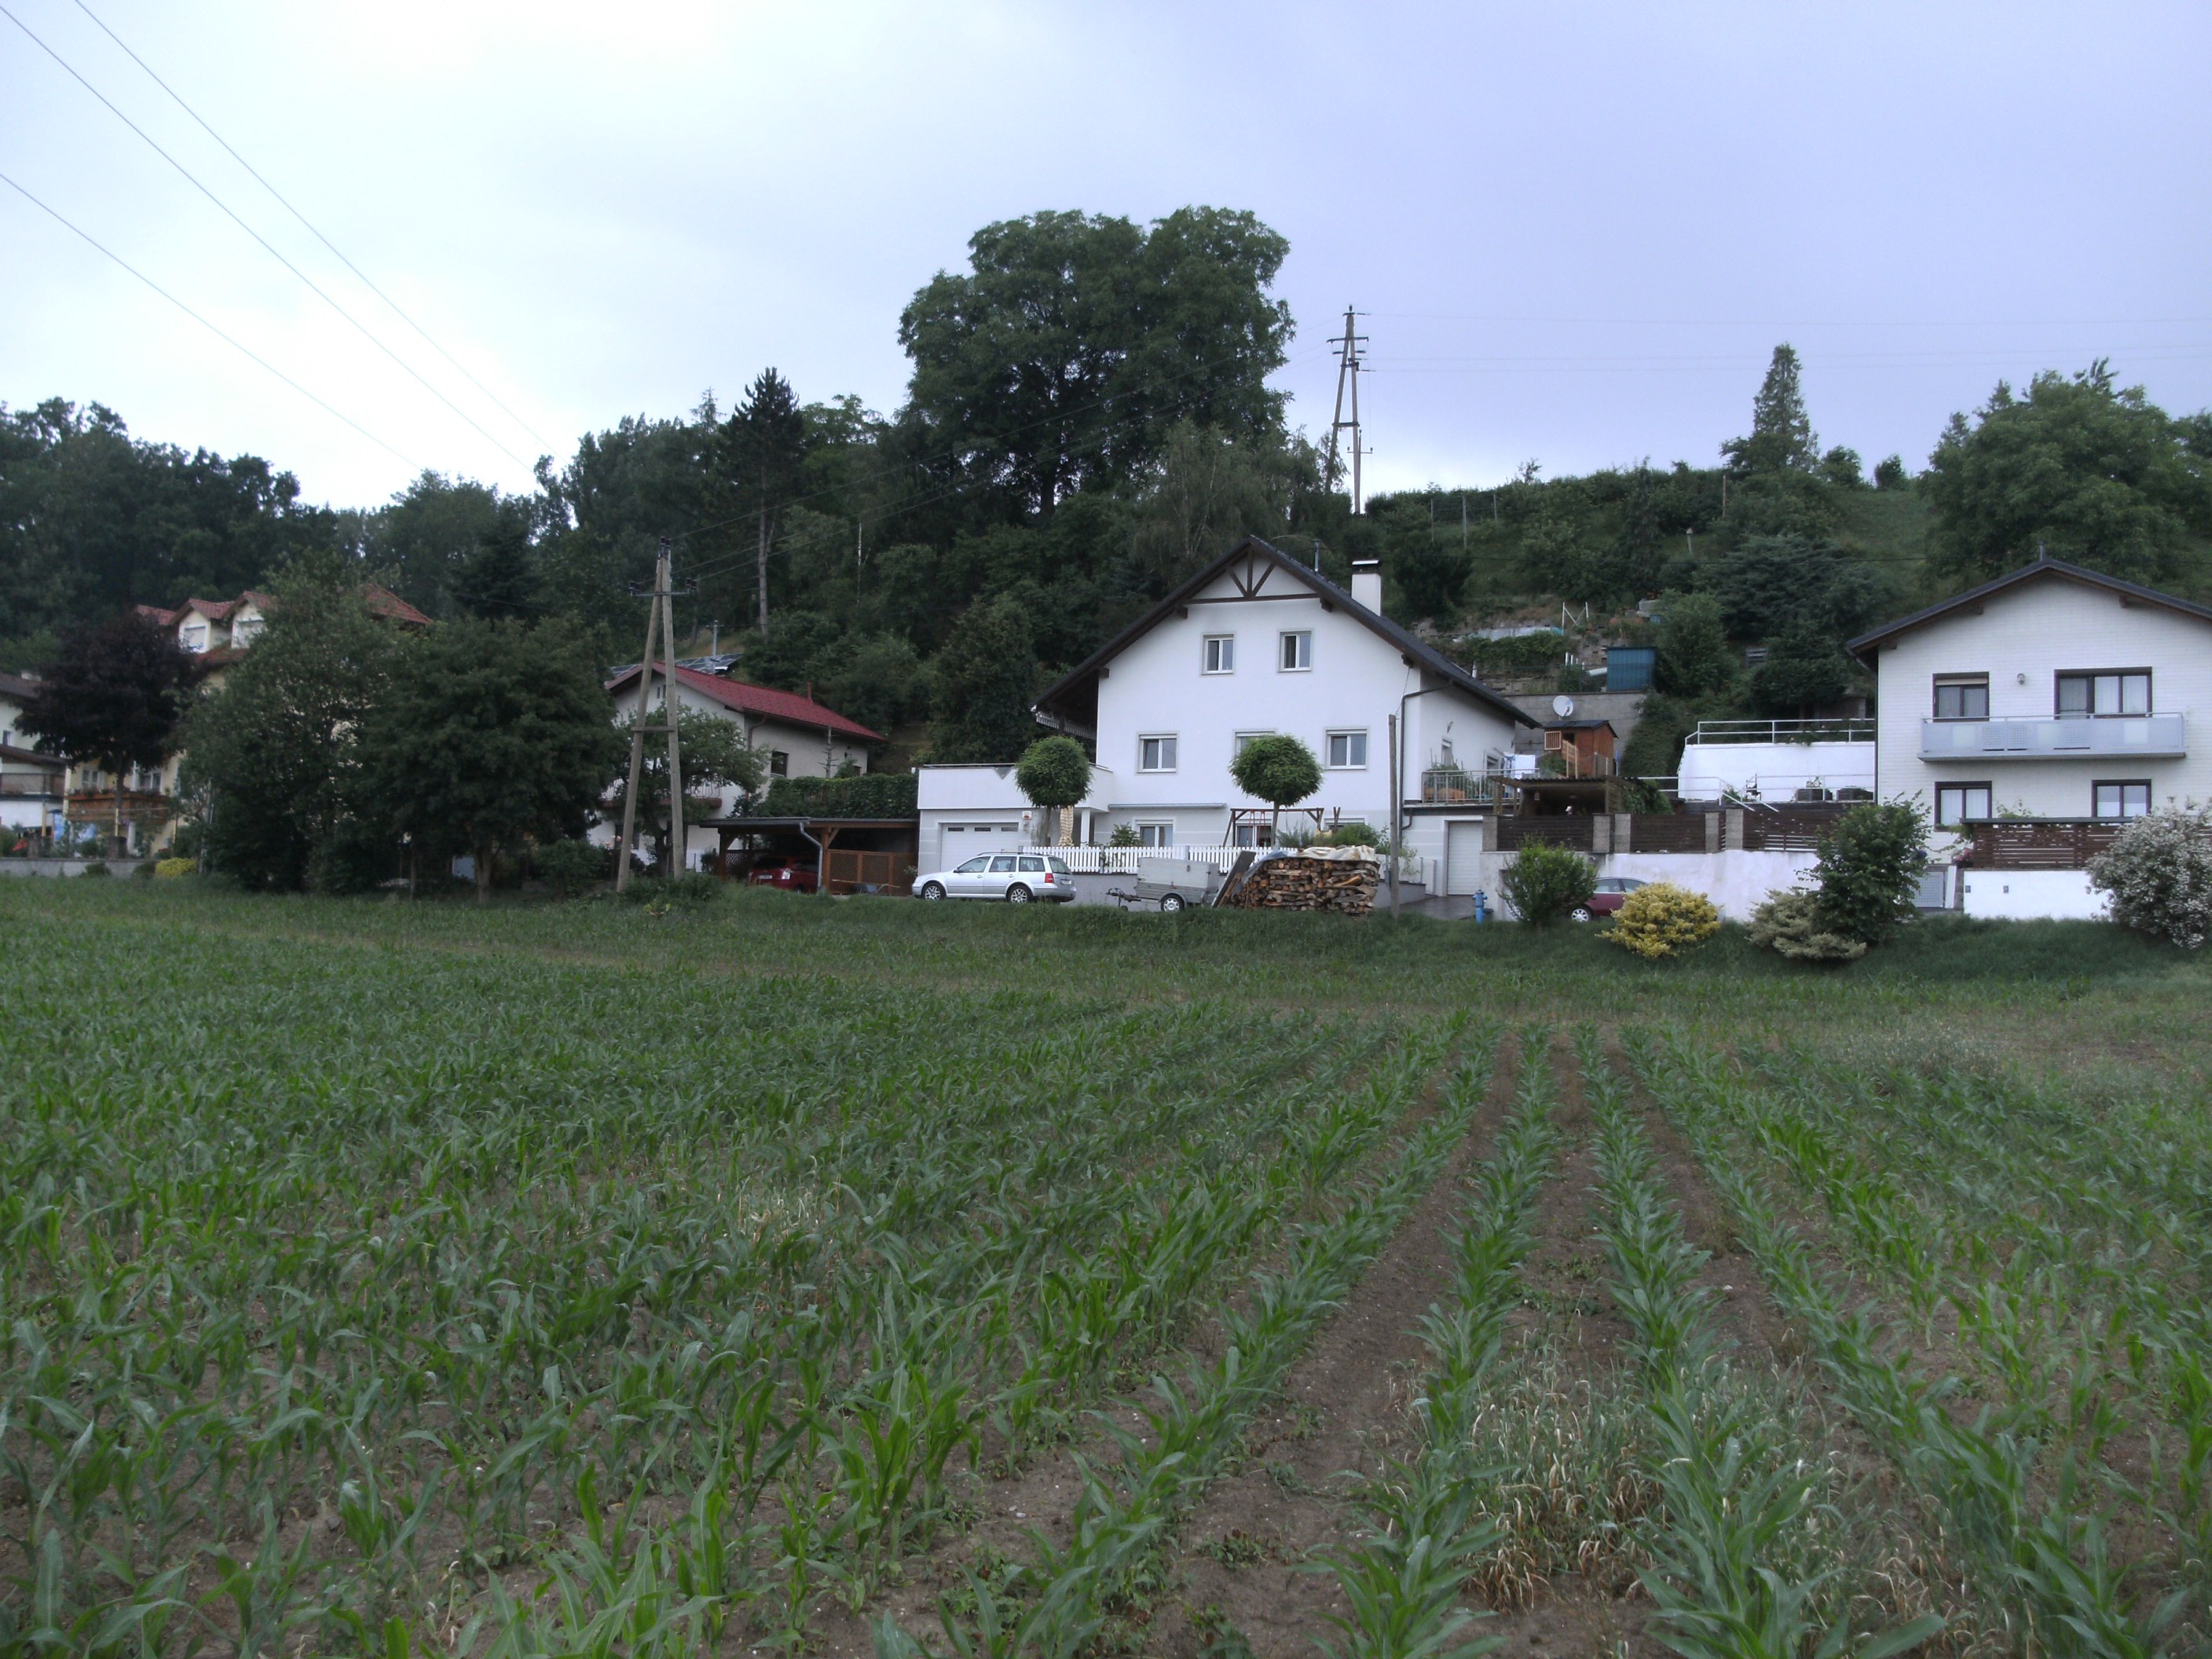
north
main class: Cropland
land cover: Maize
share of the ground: 25 - 50 %
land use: Agriculture (excluding fallow land and kitchen gardens)
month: June
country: AT
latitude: 48.3449
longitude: 14.1152
